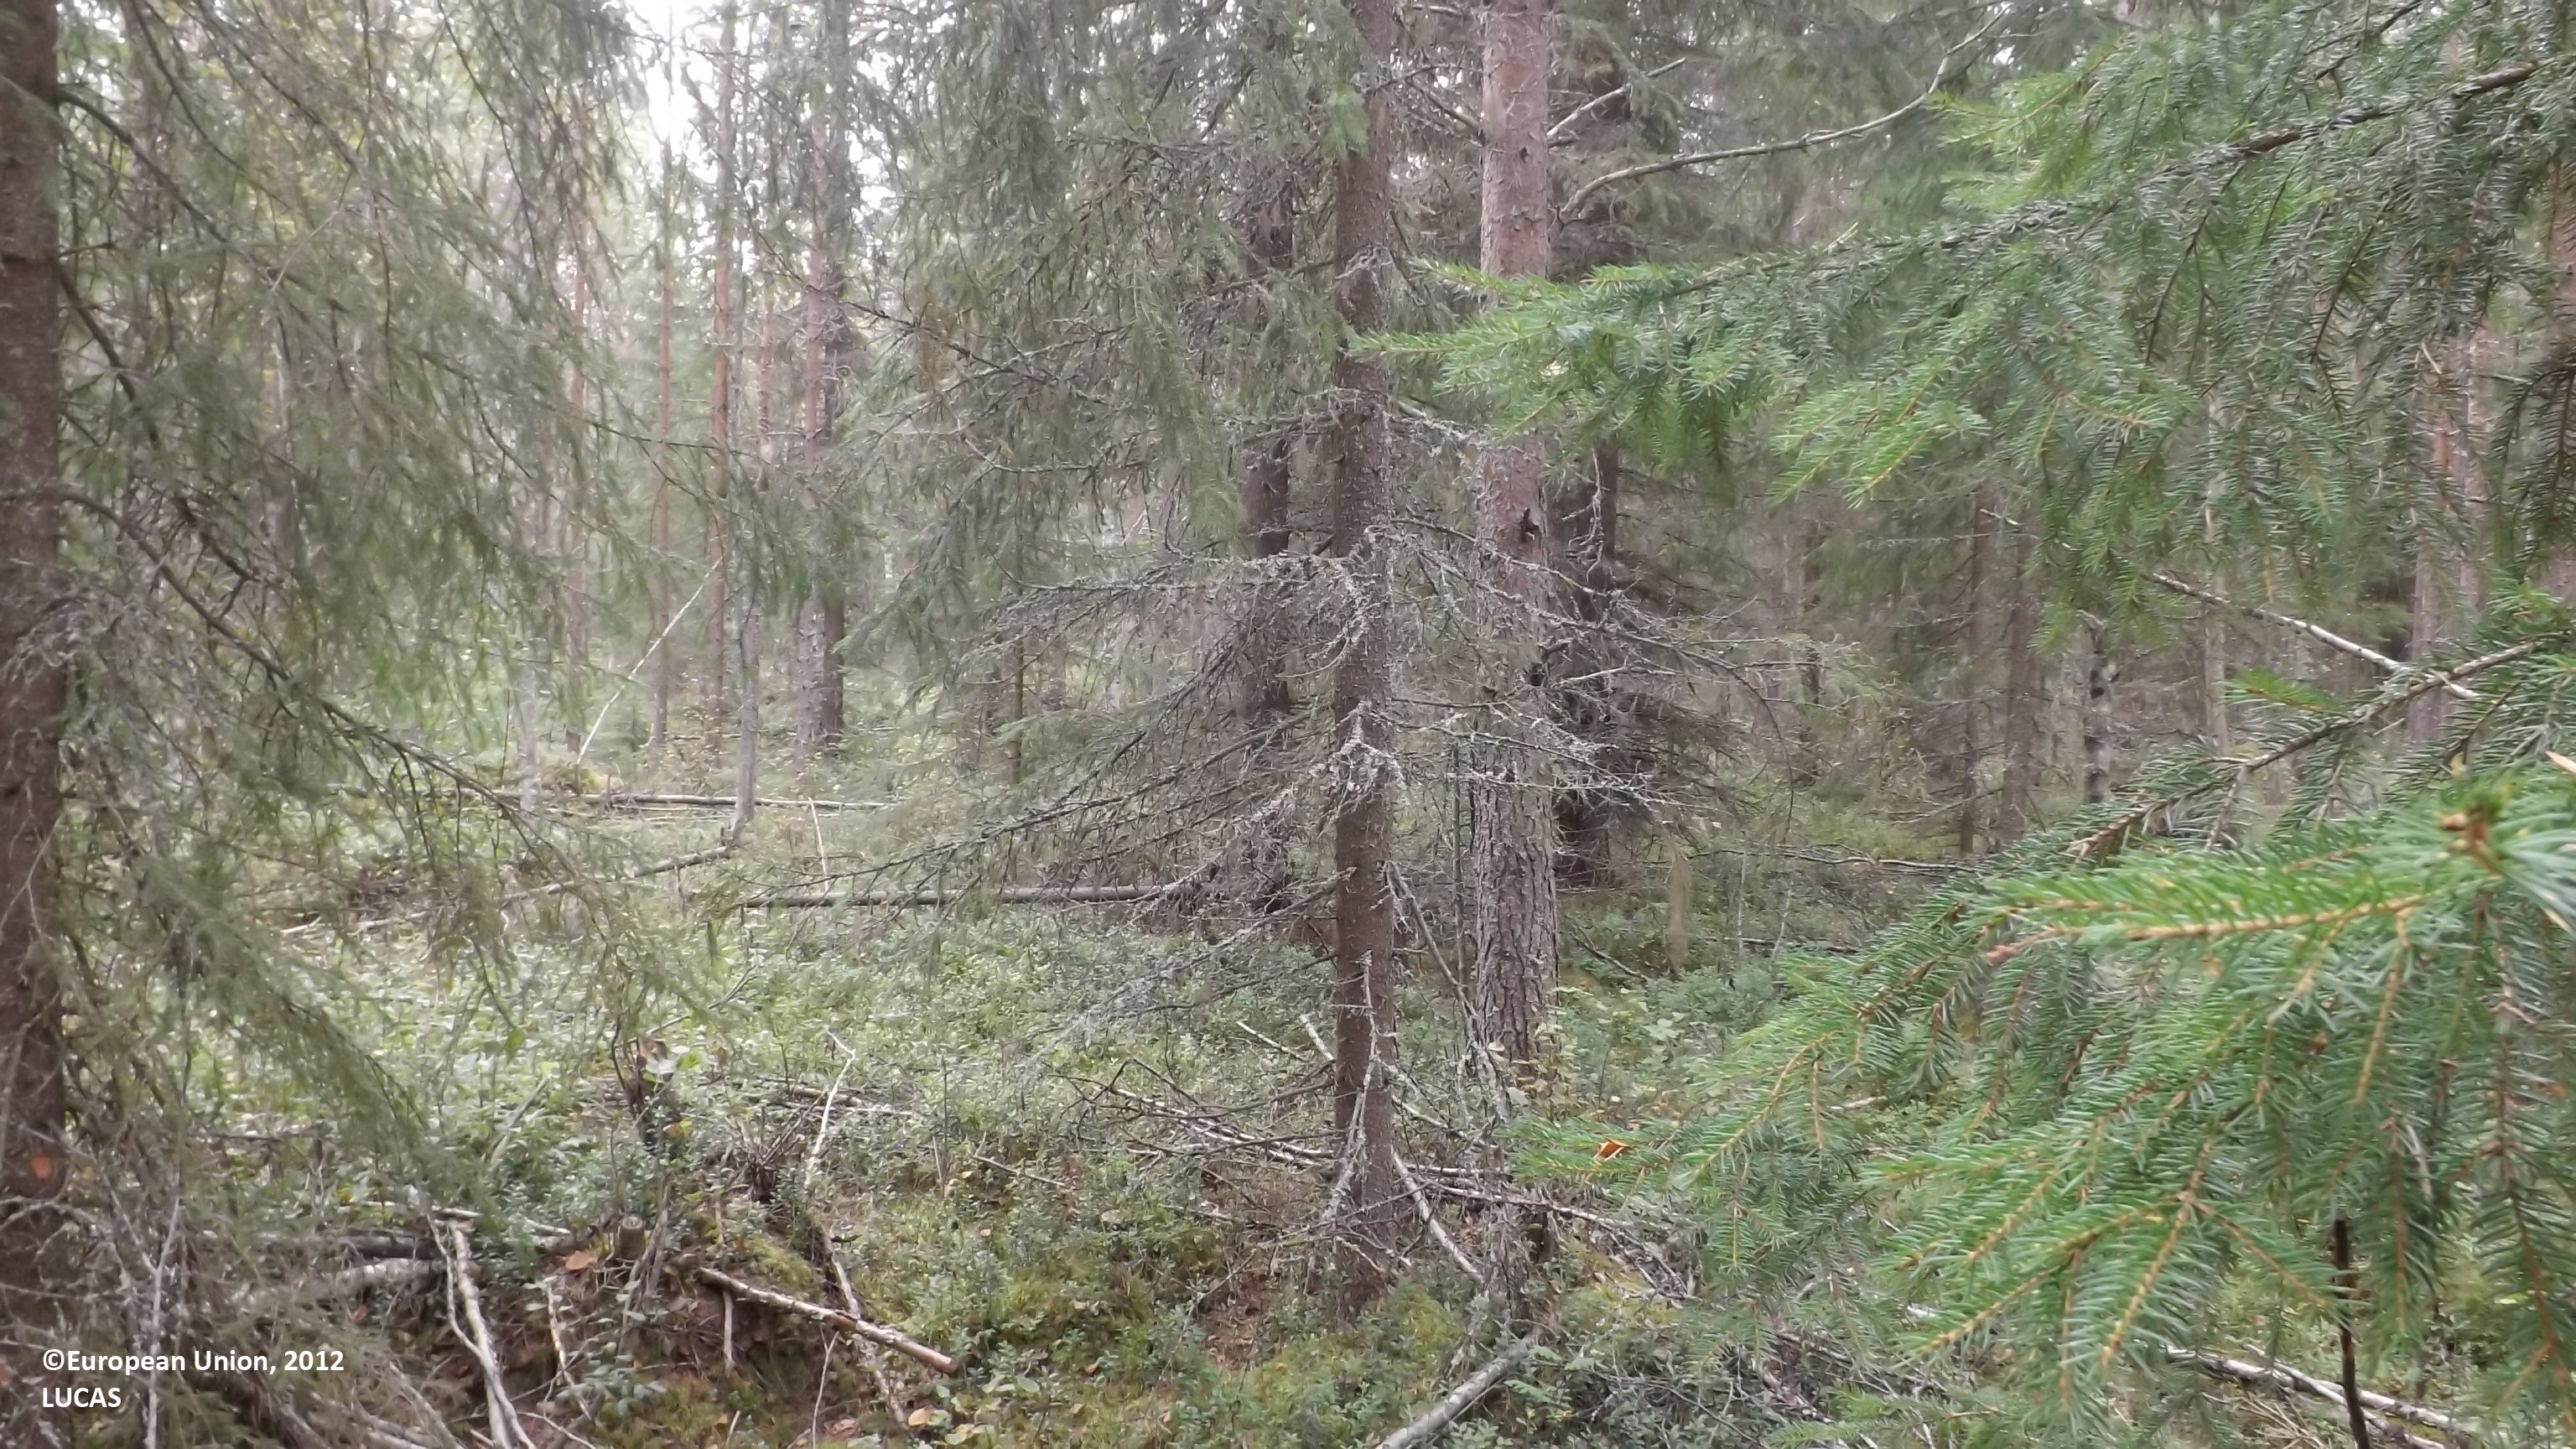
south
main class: Woodland
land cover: Other mixed woodland
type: boreal forest
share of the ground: > 75 %
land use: Forestry
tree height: > 5 m
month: August
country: FI
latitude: 63.8683
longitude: 24.1725
